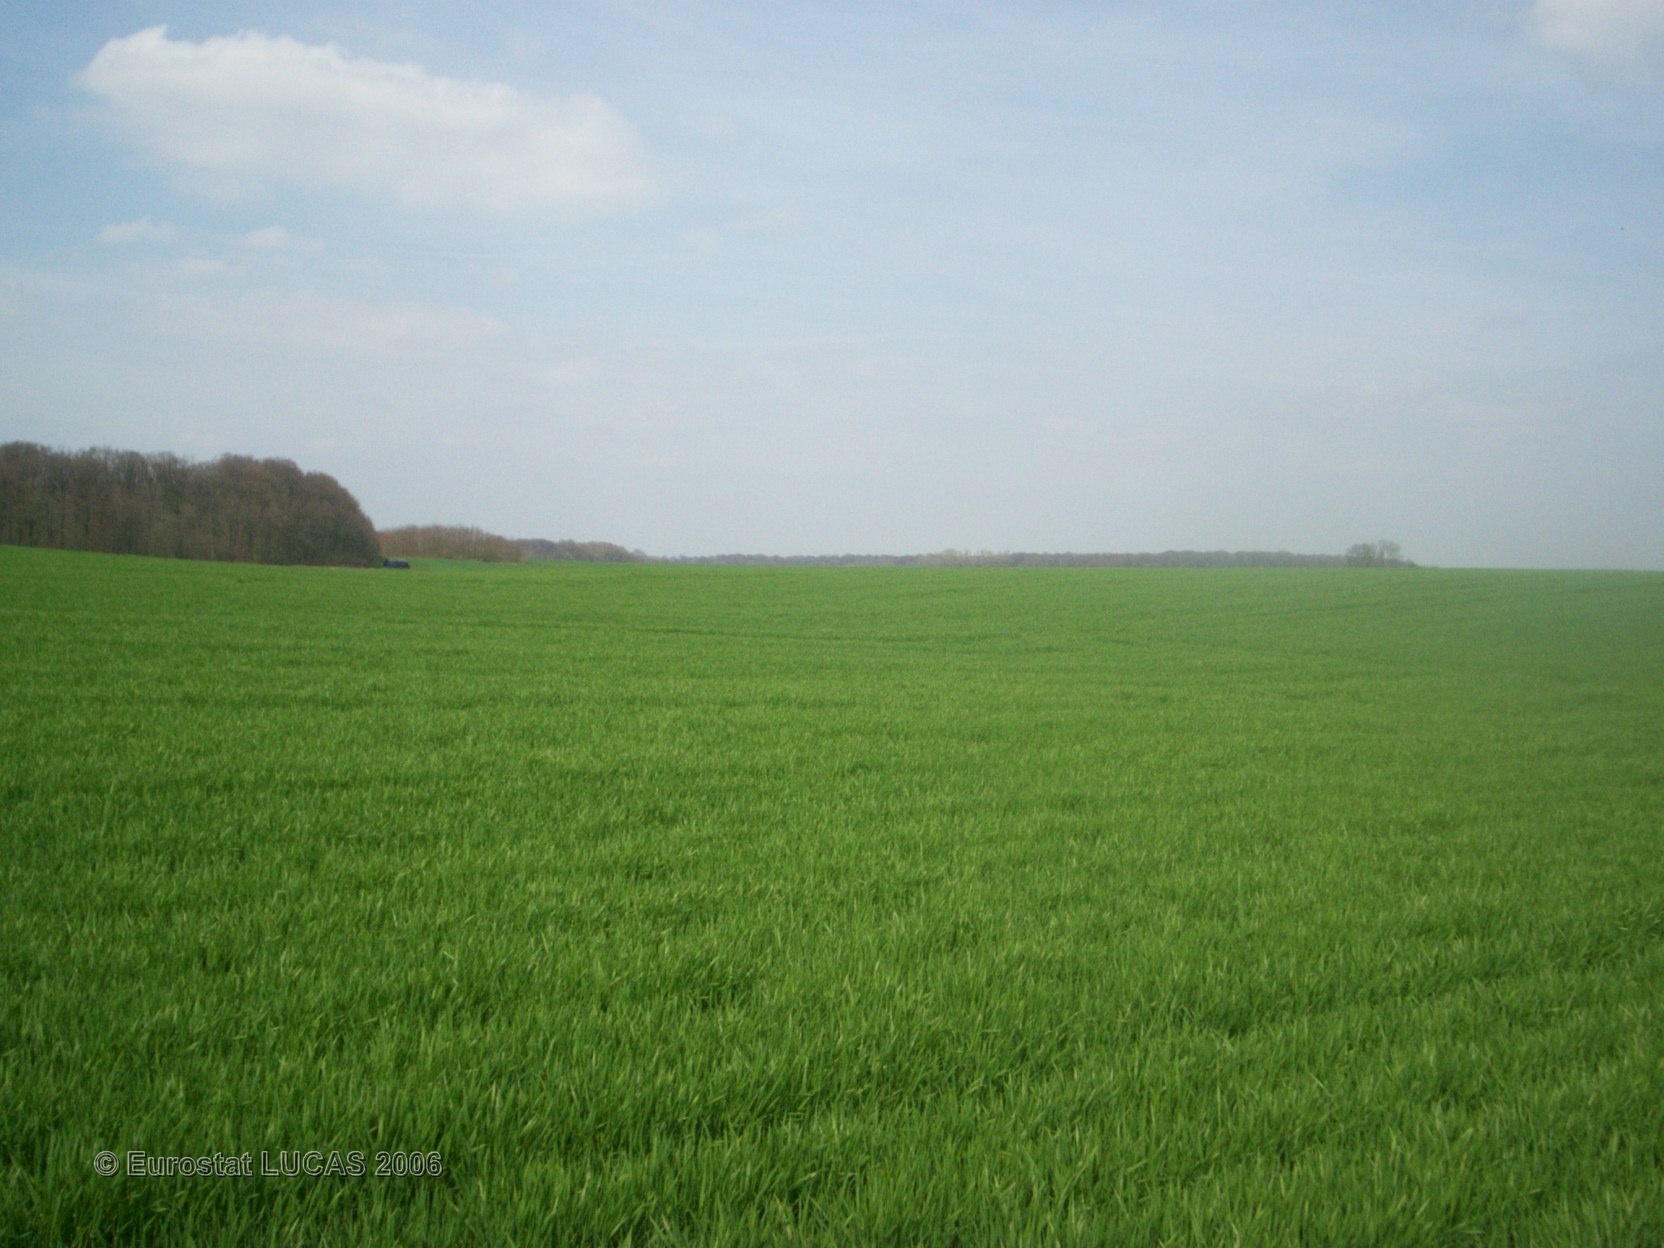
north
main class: Cropland
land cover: Barley
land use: Agriculture (excluding fallow land and kitchen gardens)
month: April
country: FR
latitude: 48.8742
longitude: 5.1581
